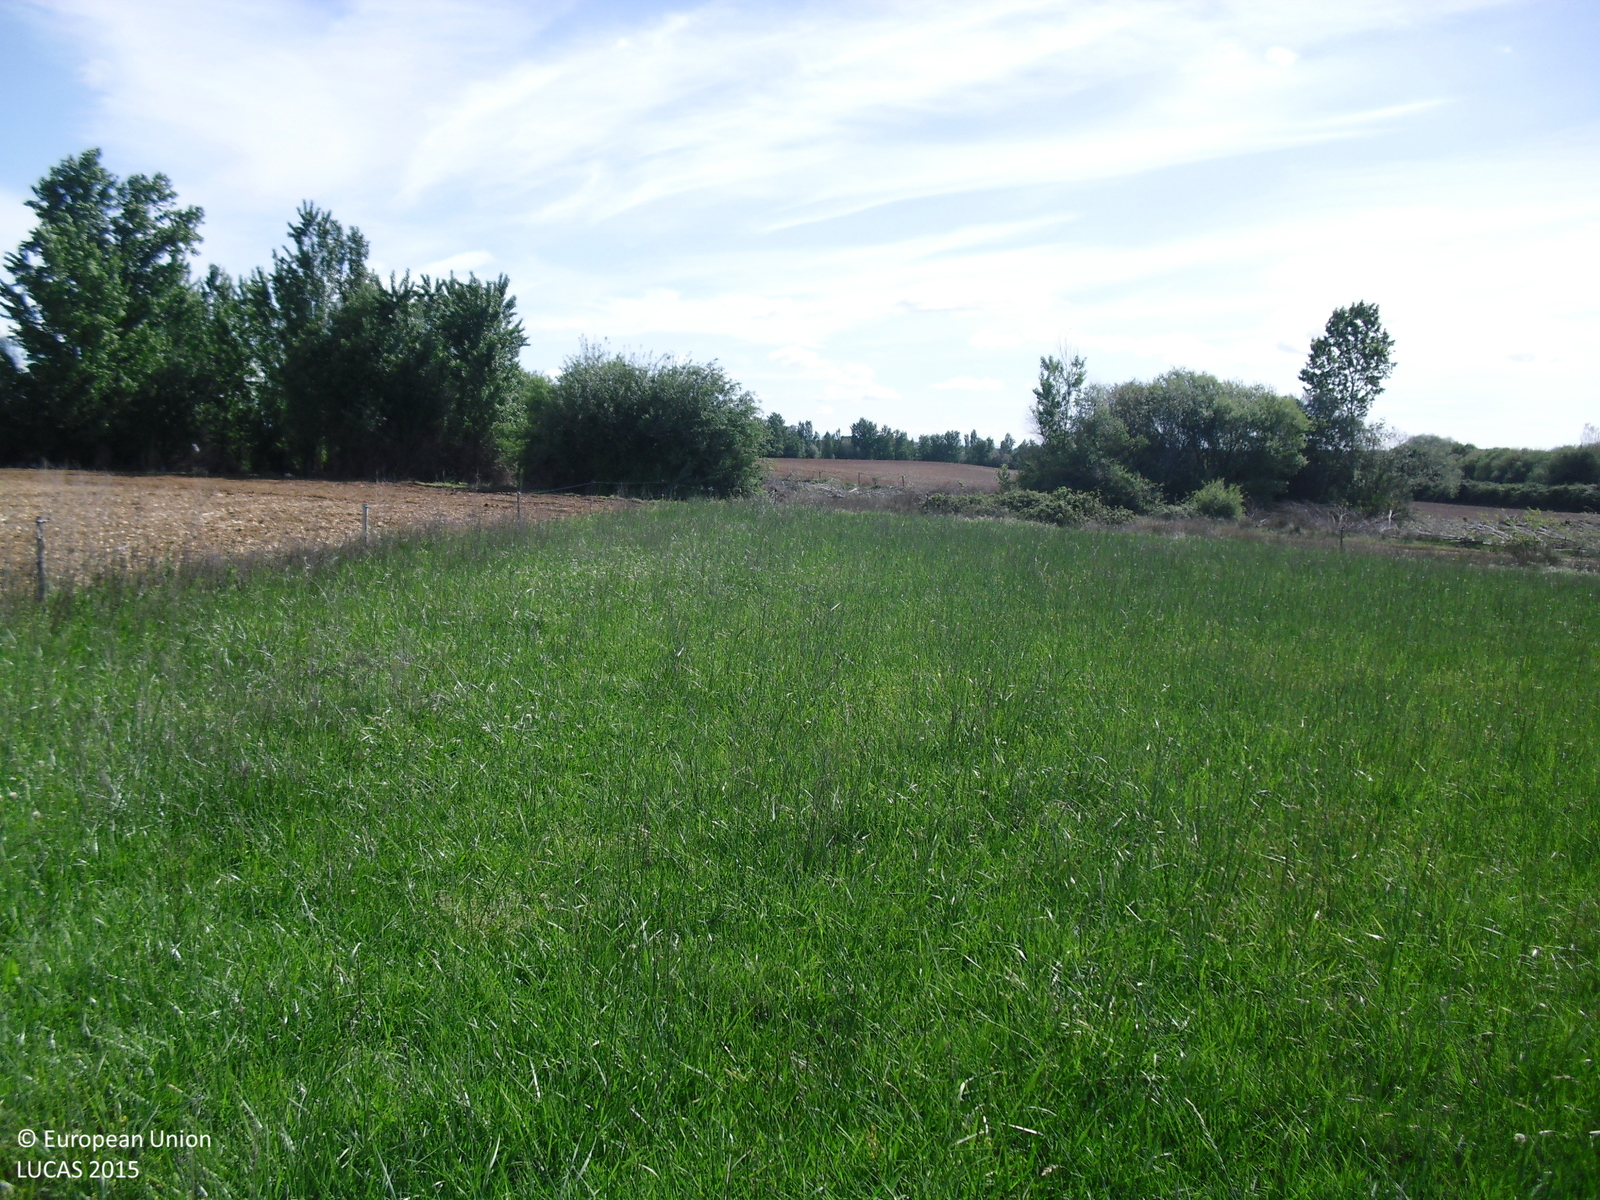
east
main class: Cropland
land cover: Temporary grasslands
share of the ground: > 75 %
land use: Agriculture (excluding fallow land and kitchen gardens)
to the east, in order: Temporary grasslands; Fences; Grassland without tree/shrub cover; Tracks; Groves; Rivers and streams; Groves; Grassland without tree/shrub cover; Fences; Other bare soil
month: April
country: ES
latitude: 40.0165
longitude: -6.7333
